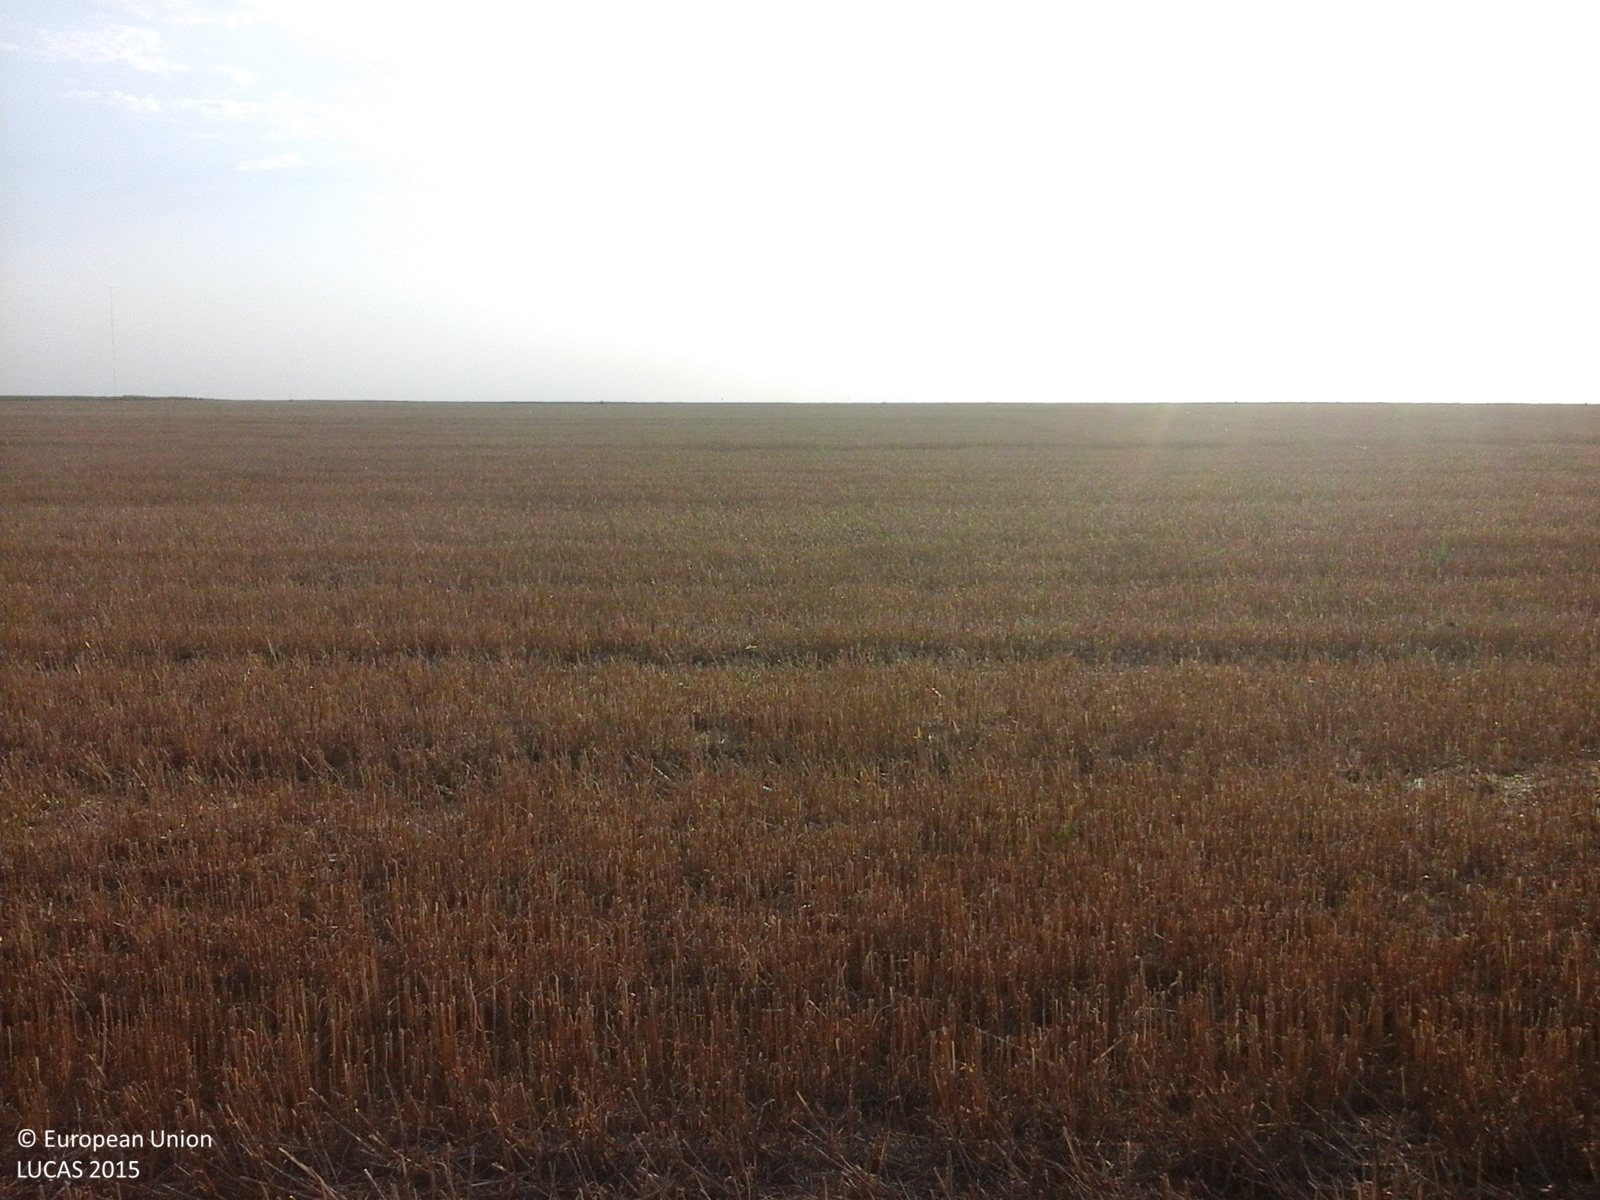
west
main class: Cropland
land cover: Barley
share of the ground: > 75 %
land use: Agriculture (excluding fallow land and kitchen gardens)
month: August
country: RO
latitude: 44.0406
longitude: 28.0622
